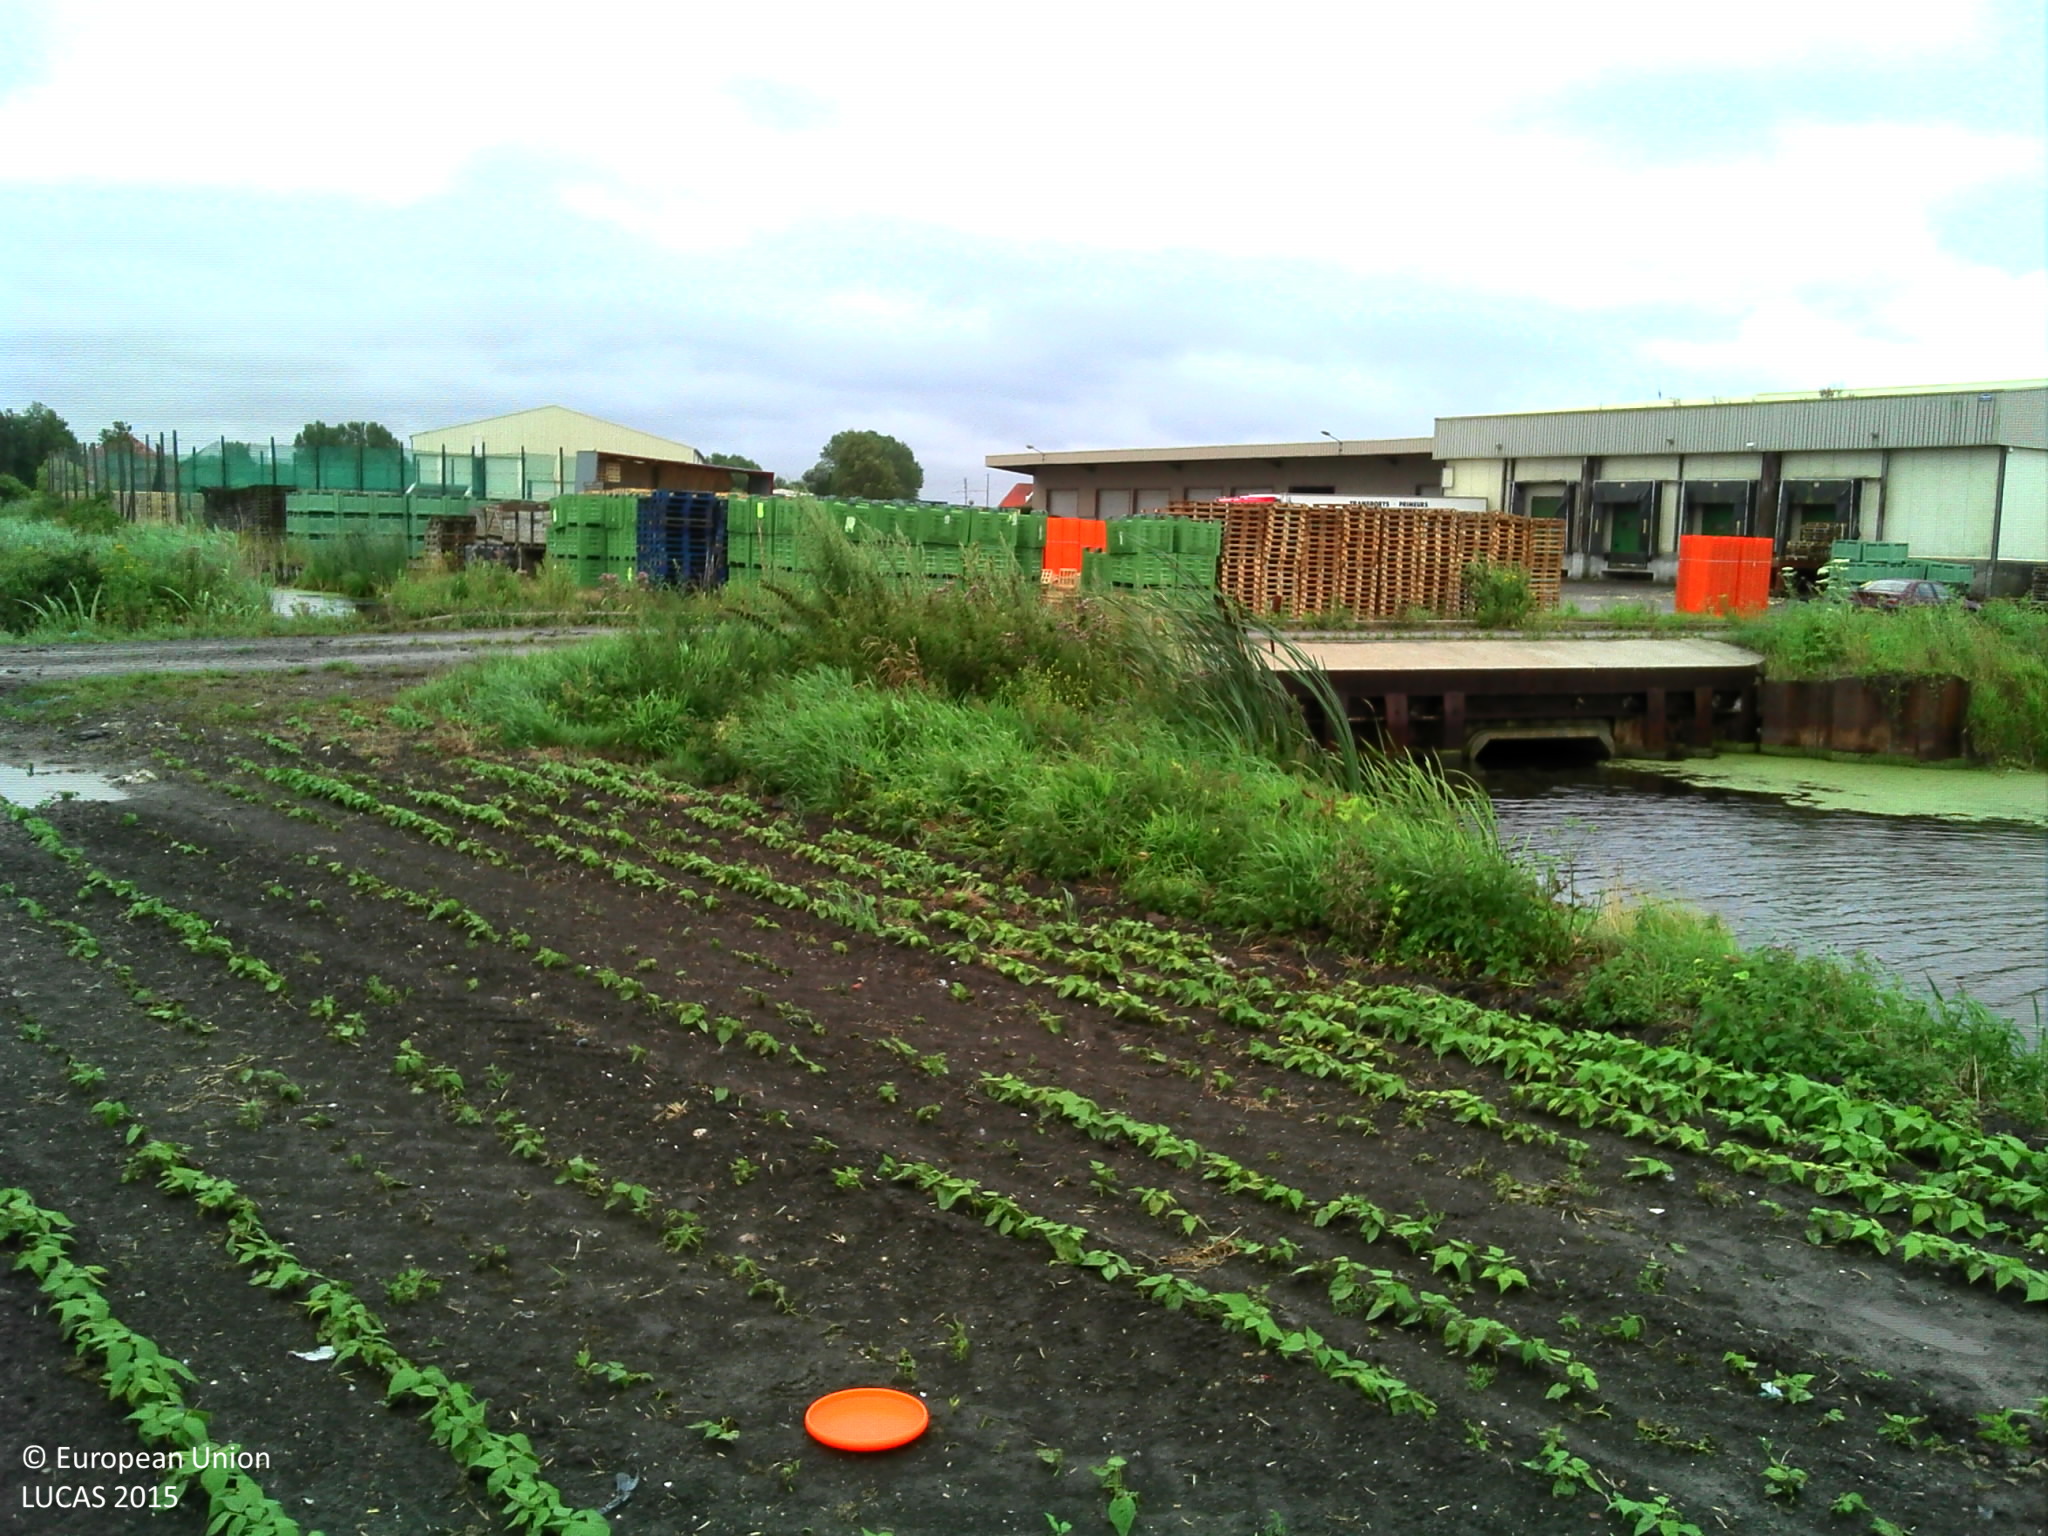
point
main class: Cropland
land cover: Other fresh vegetables
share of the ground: 25 - 50 %
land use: Agriculture (excluding fallow land and kitchen gardens)
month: July
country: FR
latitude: 50.7698
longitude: 2.2580
